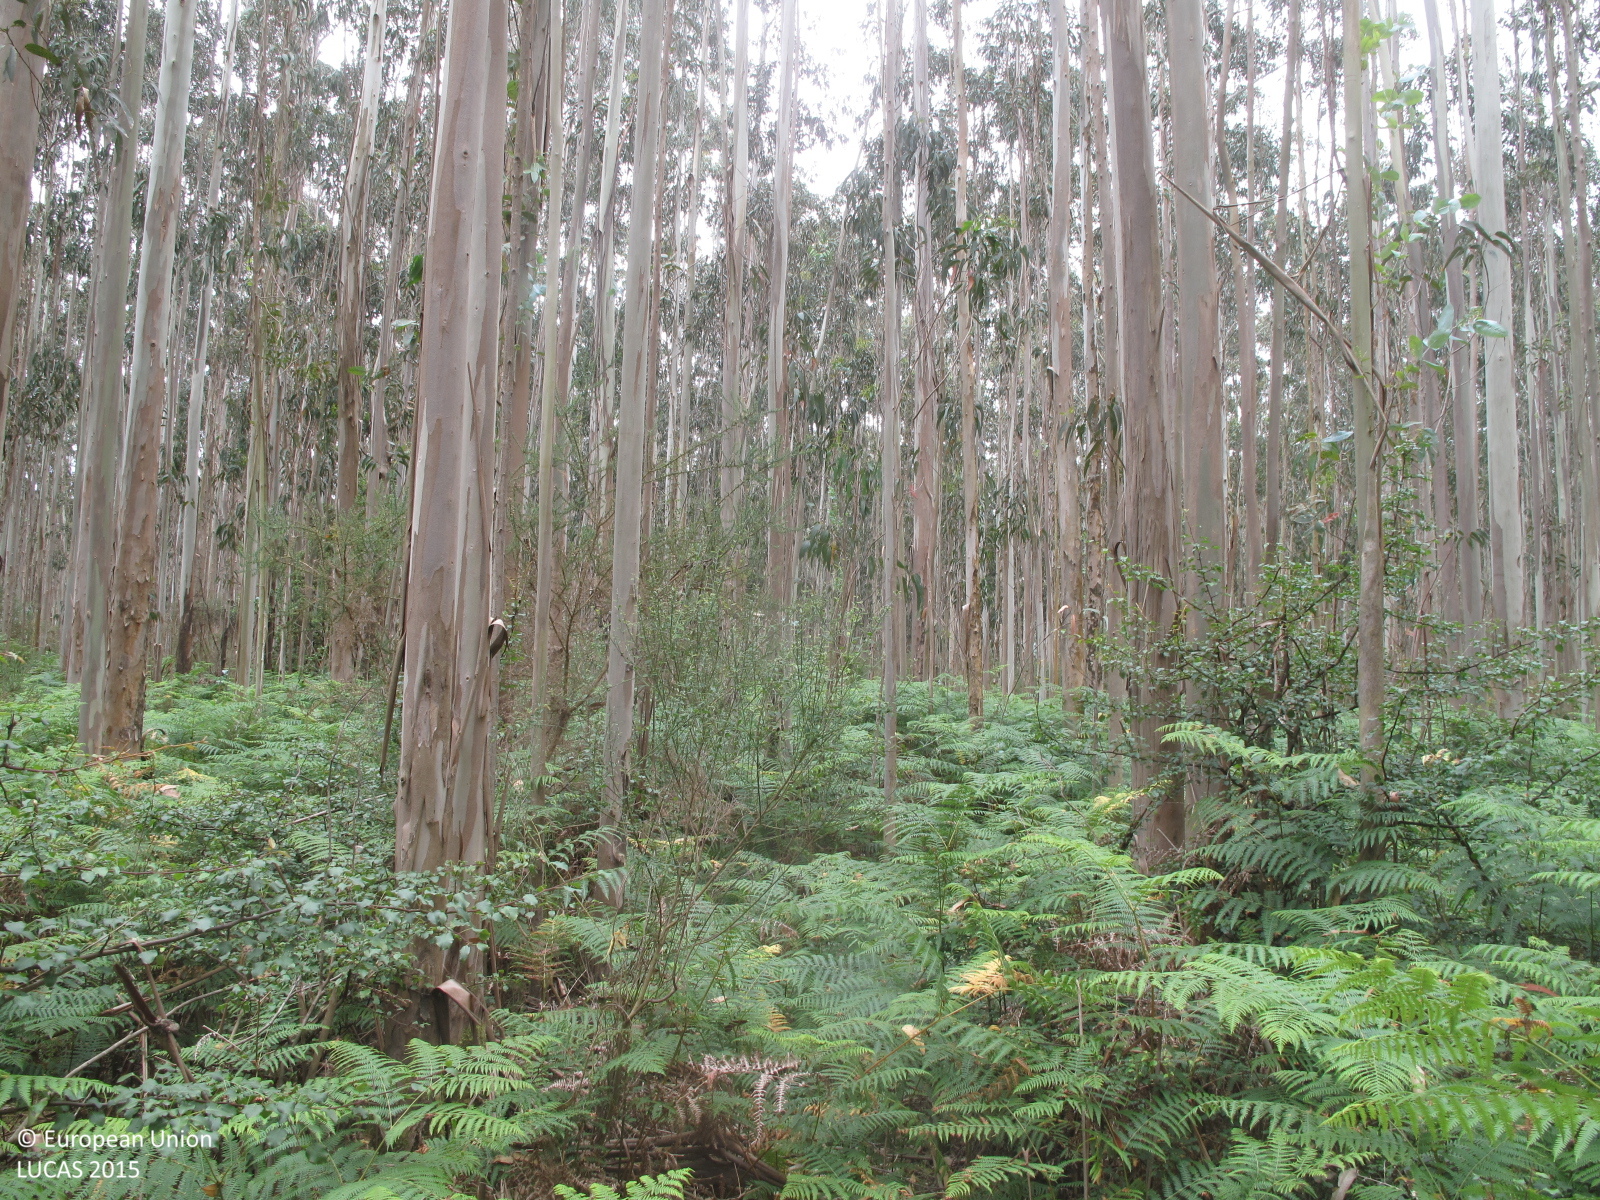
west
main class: Woodland
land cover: Broadleaved woodland
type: exotic forest
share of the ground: > 75 %
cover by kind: broadleaved forest trees 80 %, herbaceous plants 15 %, shrubs 5 %
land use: Forestry
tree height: > 5 m
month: July
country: ES
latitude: 43.6177
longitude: -8.0546
